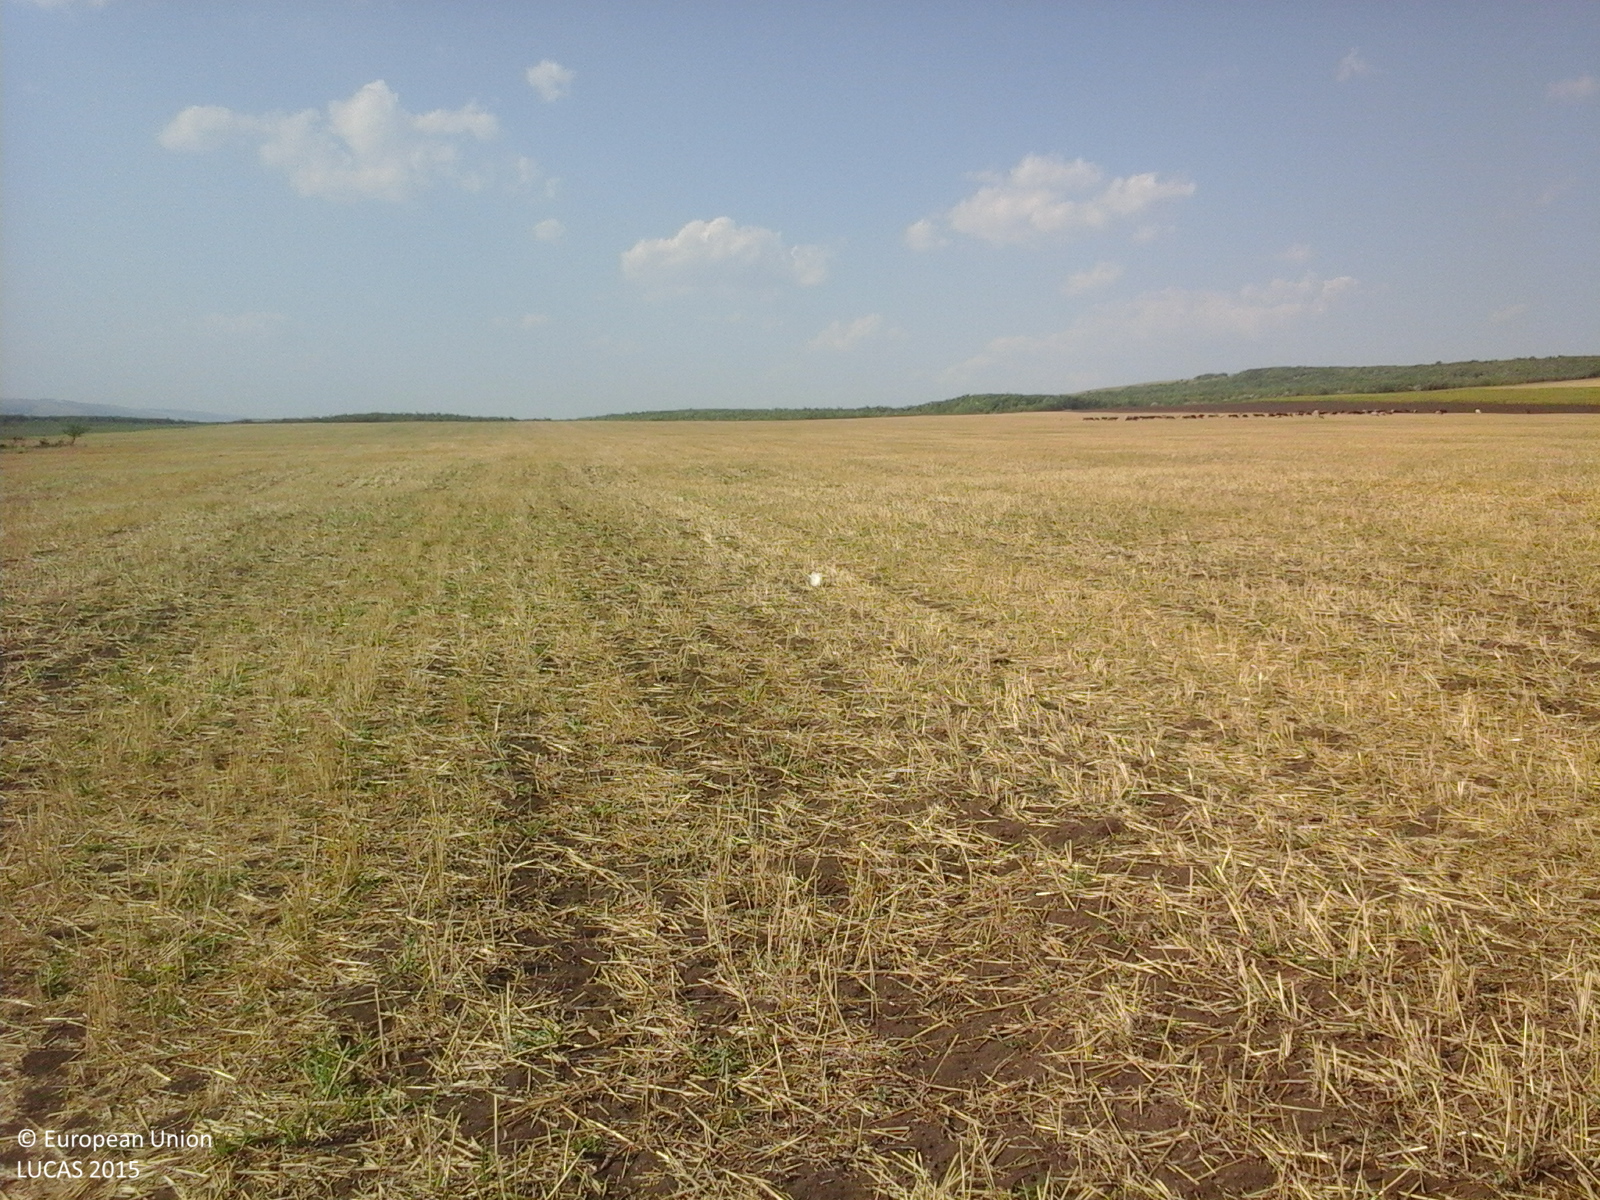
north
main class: Cropland
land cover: Common wheat
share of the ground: < 10 %
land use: Agriculture (excluding fallow land and kitchen gardens)
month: July
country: RO
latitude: 46.3612
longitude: 27.7548
